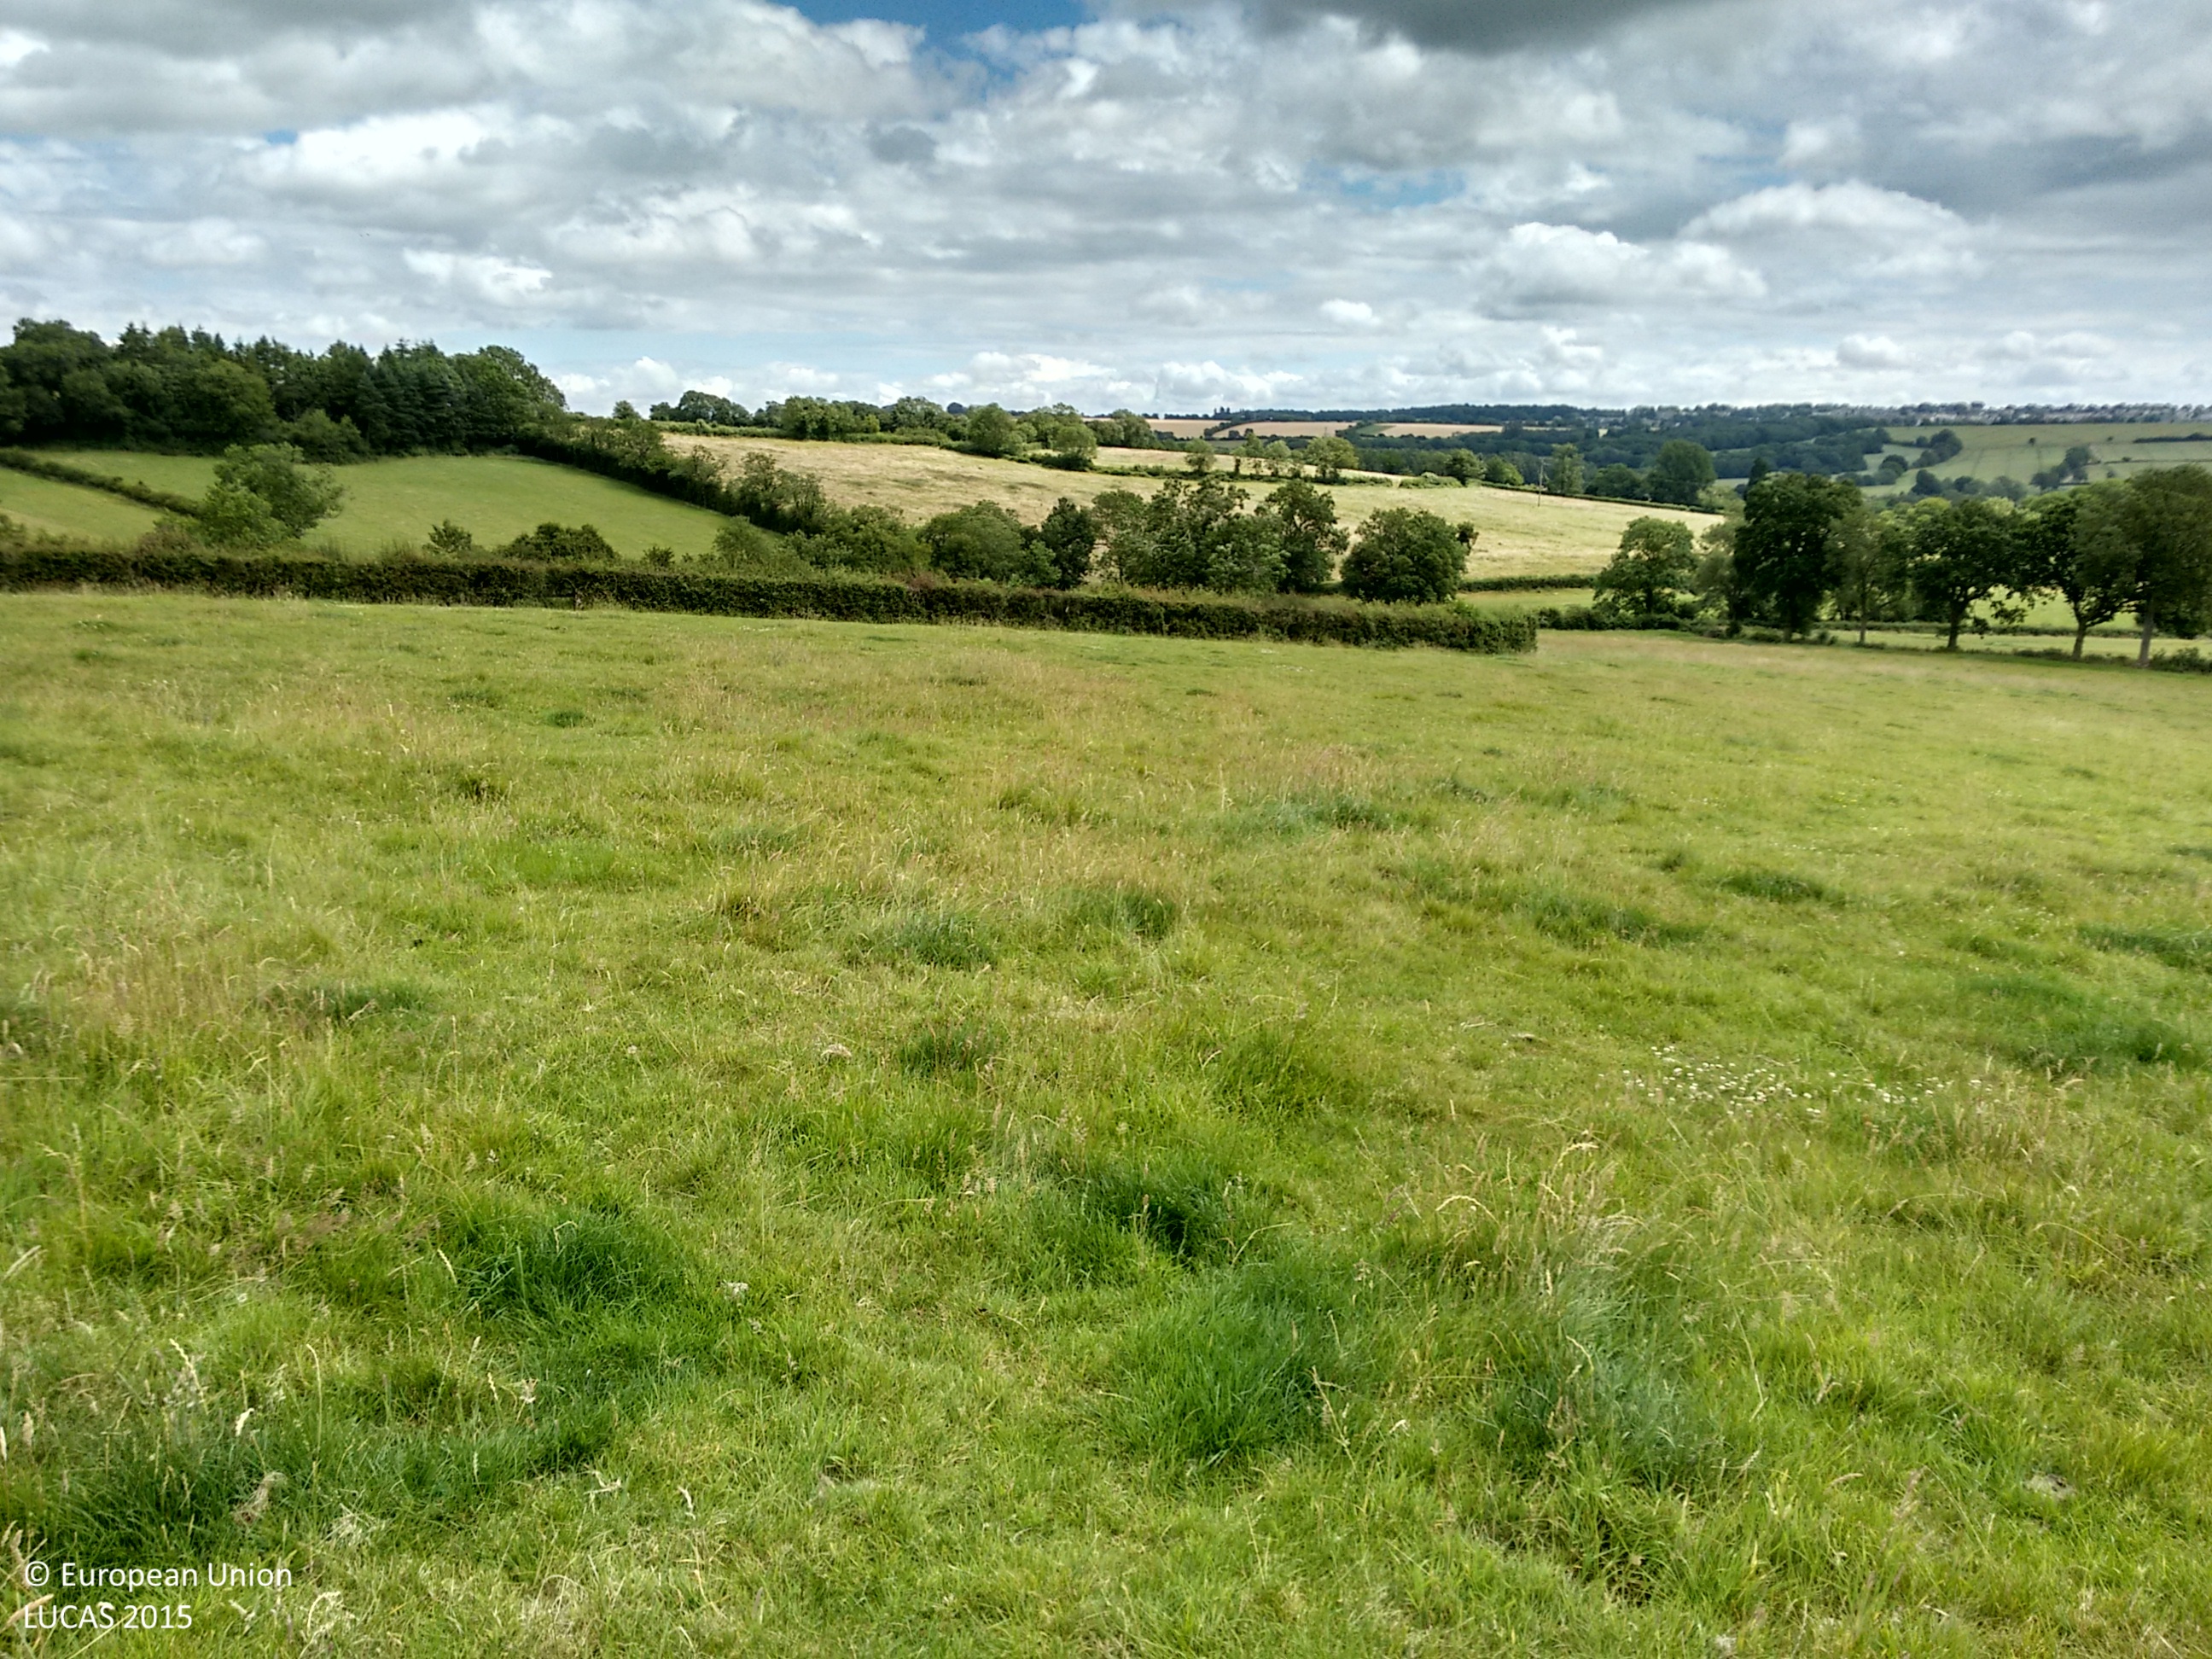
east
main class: Grassland
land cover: Grassland without tree/shrub cover
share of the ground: > 75 %
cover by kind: herbaceous plants 100 %
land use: Agriculture (excluding fallow land and kitchen gardens)
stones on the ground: < 10 %
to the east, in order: Grassland without tree/shrub cover; Managed hedges; Grassland without tree/shrub cover; Managed hedges; Grassland without tree/shrub cover; Managed hedges; Grassland without tree/shrub cover; Inland fresh running water; Grassland without tree/shrub cover
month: July
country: GB
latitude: 51.9528
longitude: -1.5910
